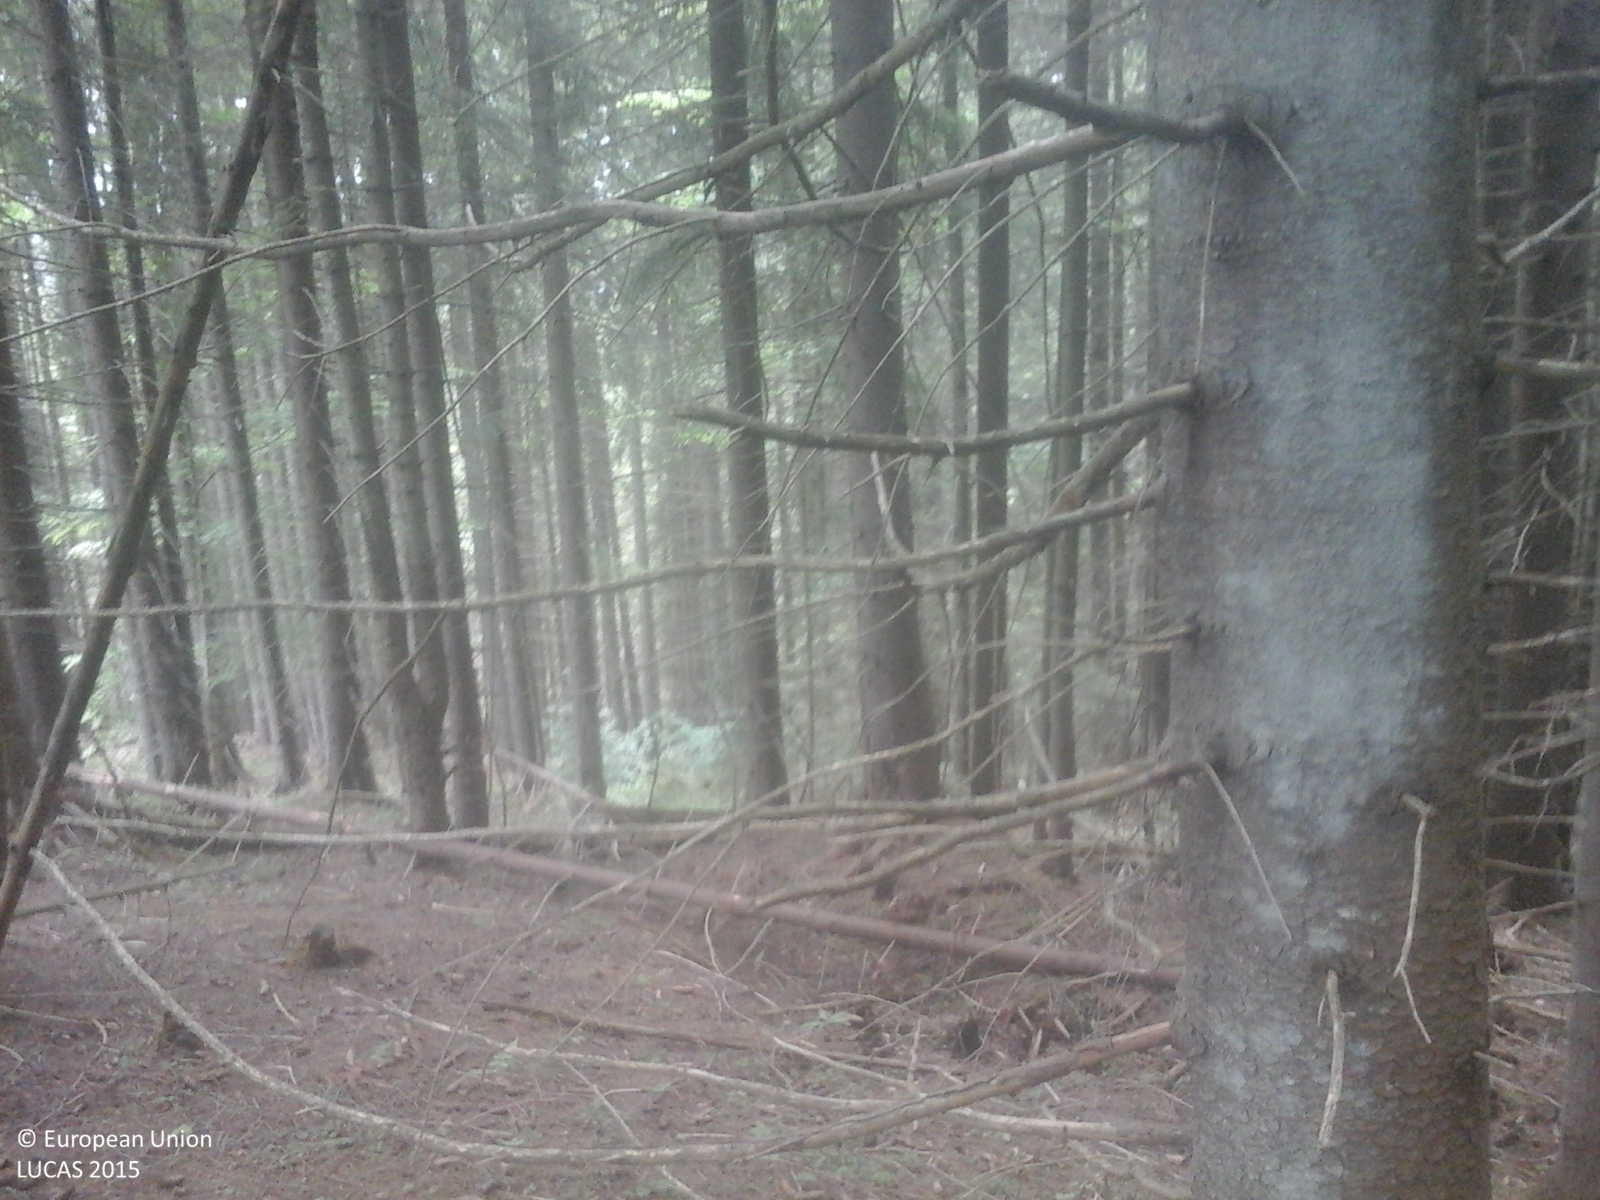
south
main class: Woodland
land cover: Spruce dominated coniferous woodland
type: alpine coniferous forest
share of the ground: > 75 %
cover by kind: coniferous forest trees 90 %, broadleaved forest trees 10 %
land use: Forestry
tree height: > 5 m
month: June
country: RO
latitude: 47.4281
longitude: 25.1272
